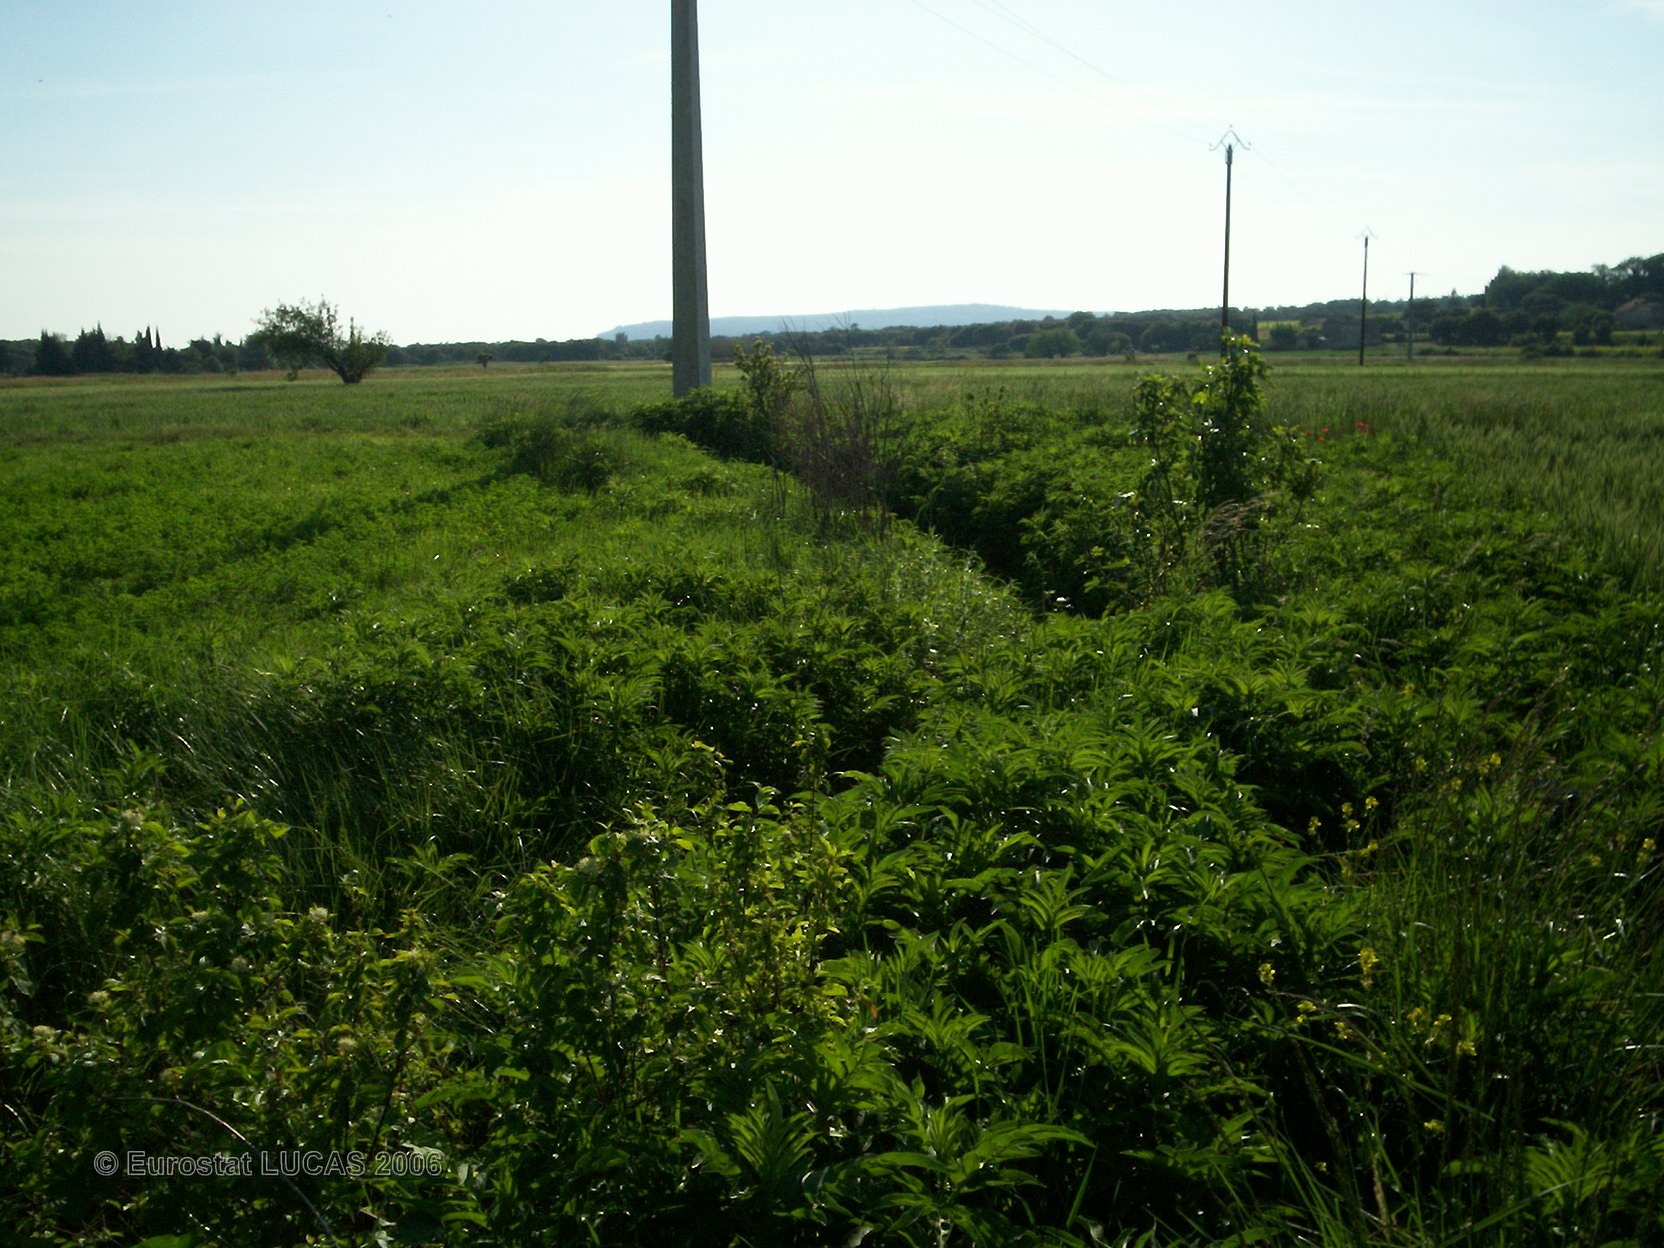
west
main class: Cropland
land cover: Barley
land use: Agriculture (excluding fallow land and kitchen gardens)
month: May
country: FR
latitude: 44.3313
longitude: 4.8531
